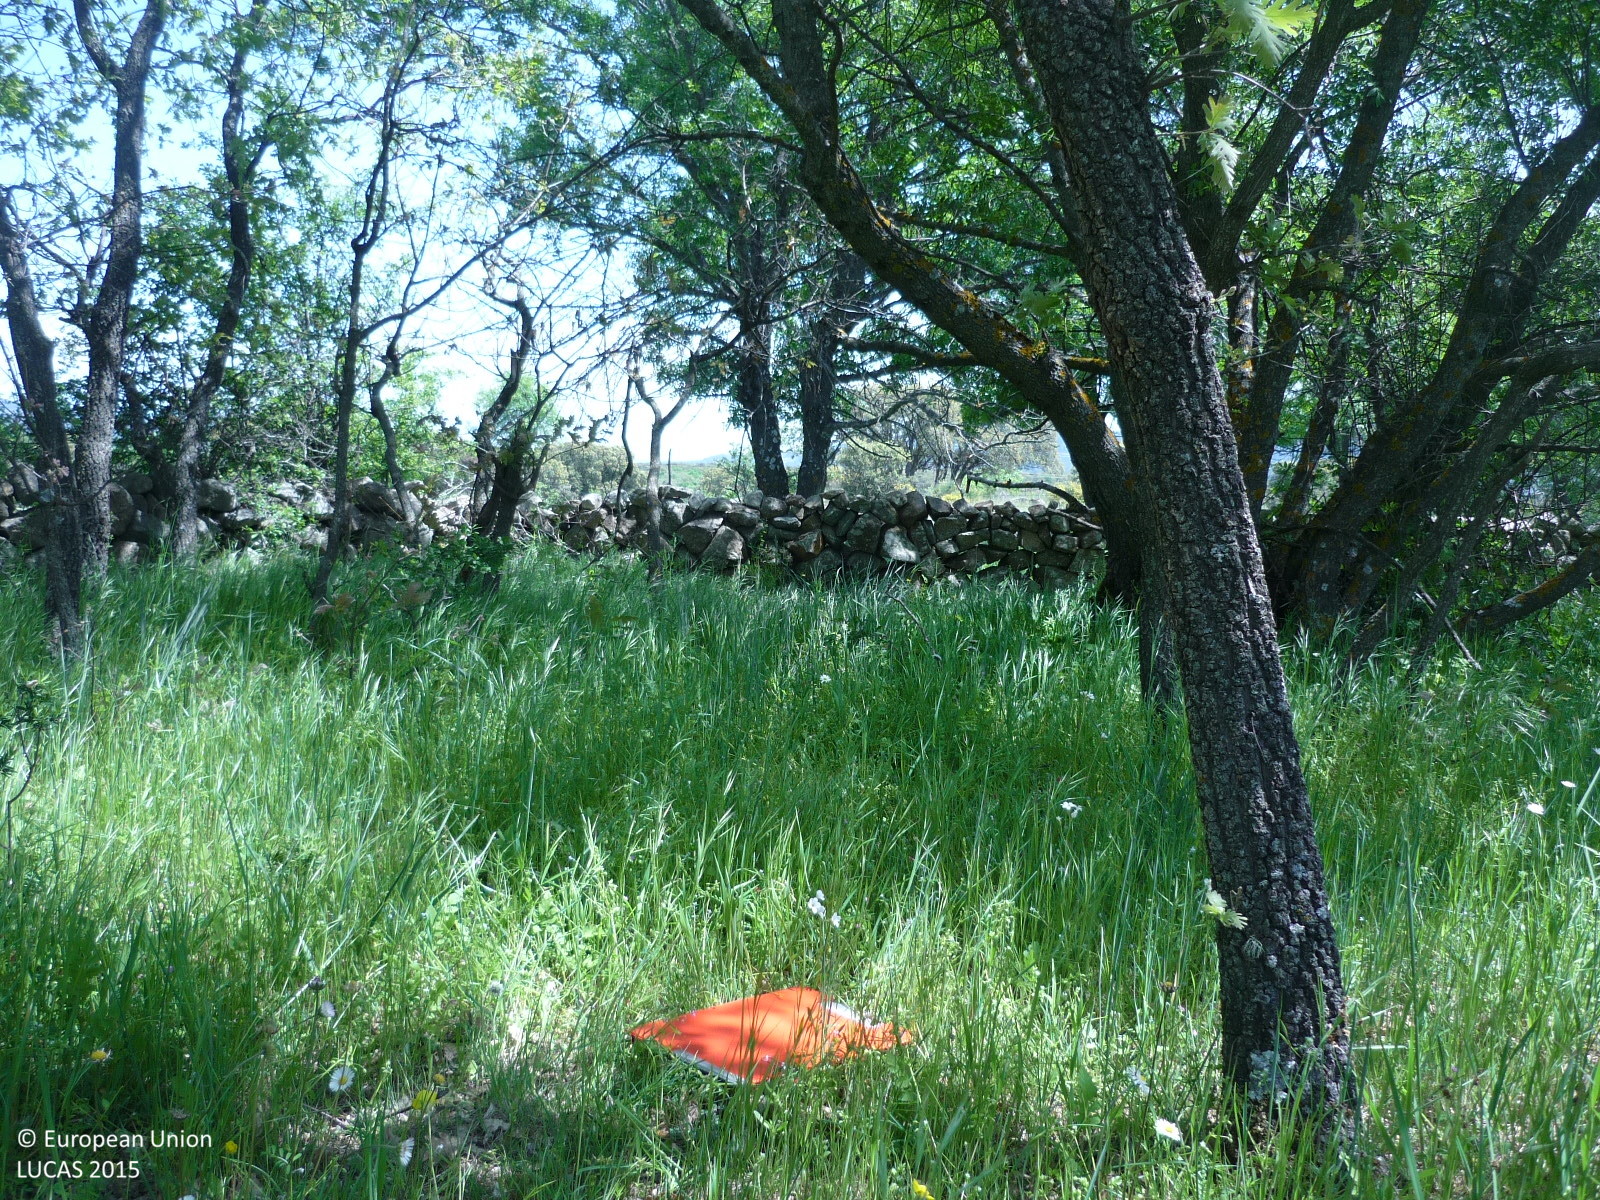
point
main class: Woodland
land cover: Broadleaved woodland
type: thermophilous deciduous forest
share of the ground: 50 - 75 %
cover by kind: broadleaved forest trees 60 %, herbaceous plants 30 %, shrubs 10 %
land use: Semi-natural and natural areas not in use
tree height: < 5 m
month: May
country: ES
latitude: 40.9280
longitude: -3.5925
